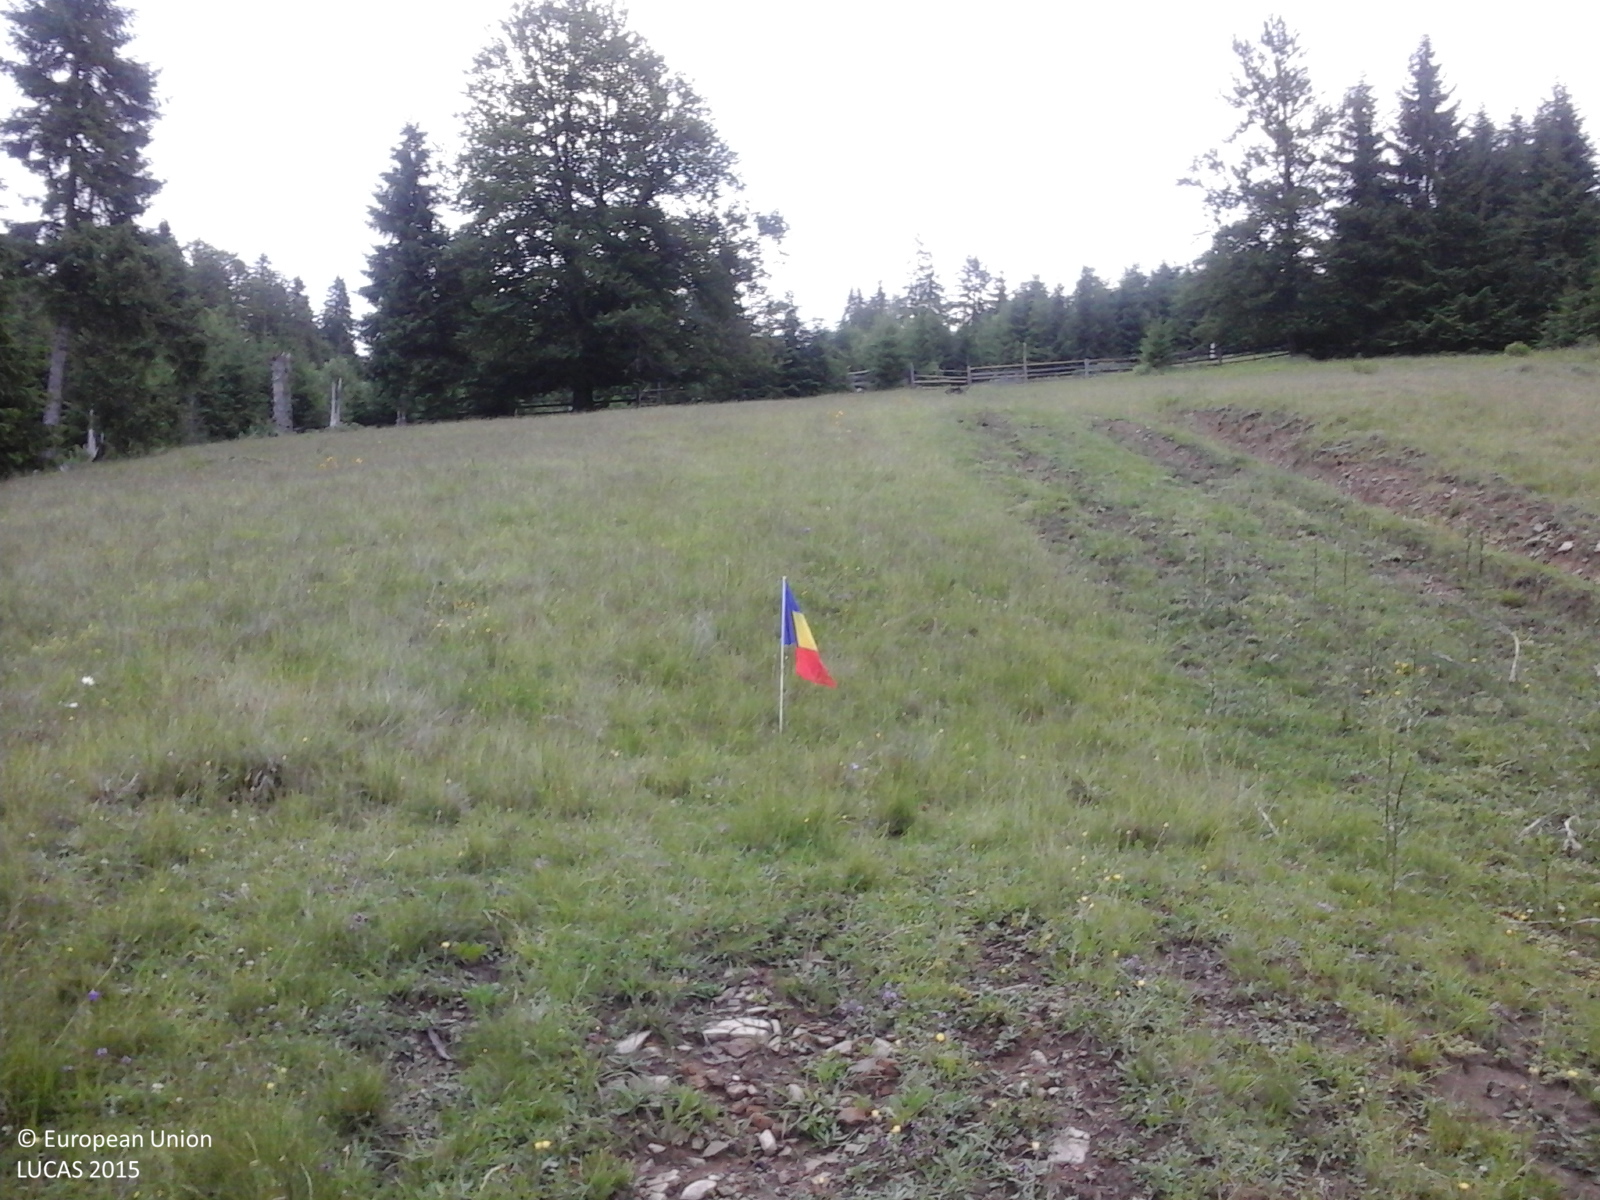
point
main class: Grassland
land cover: Grassland without tree/shrub cover
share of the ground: > 75 %
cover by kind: herbaceous plants 100 %
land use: Agriculture (excluding fallow land and kitchen gardens)
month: June
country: RO
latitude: 47.3754
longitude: 25.1115
